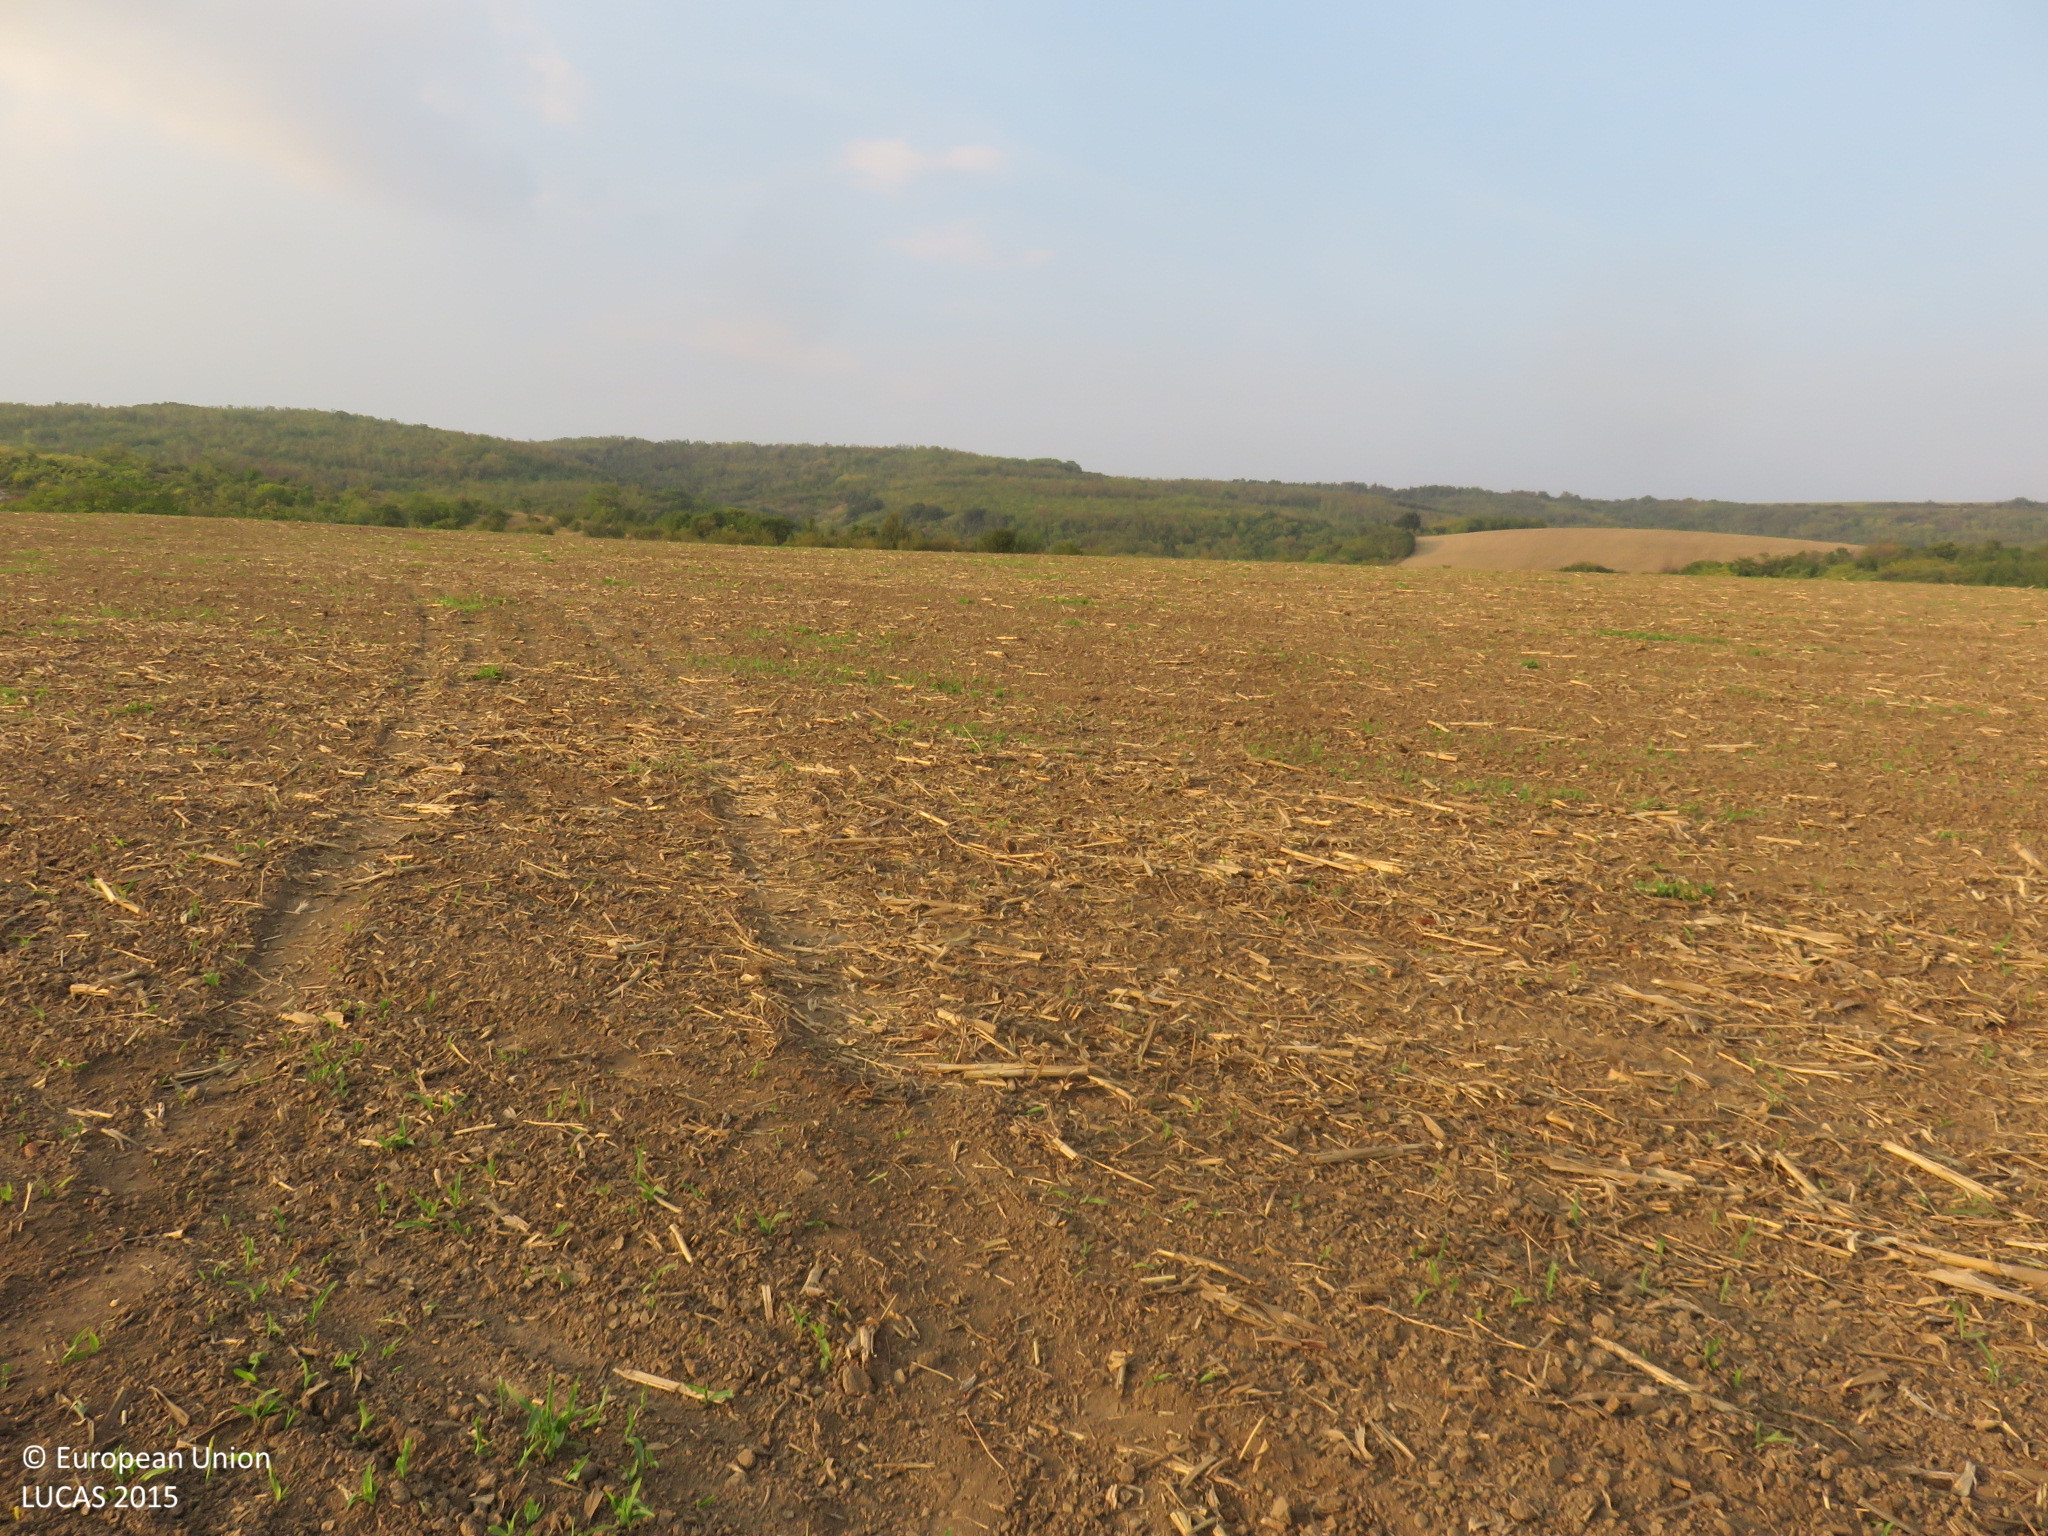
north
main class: Cropland
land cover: Maize
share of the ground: < 10 %
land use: Agriculture (excluding fallow land and kitchen gardens)
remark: Harvested field
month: September
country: BG
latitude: 43.5693
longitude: 24.9664
